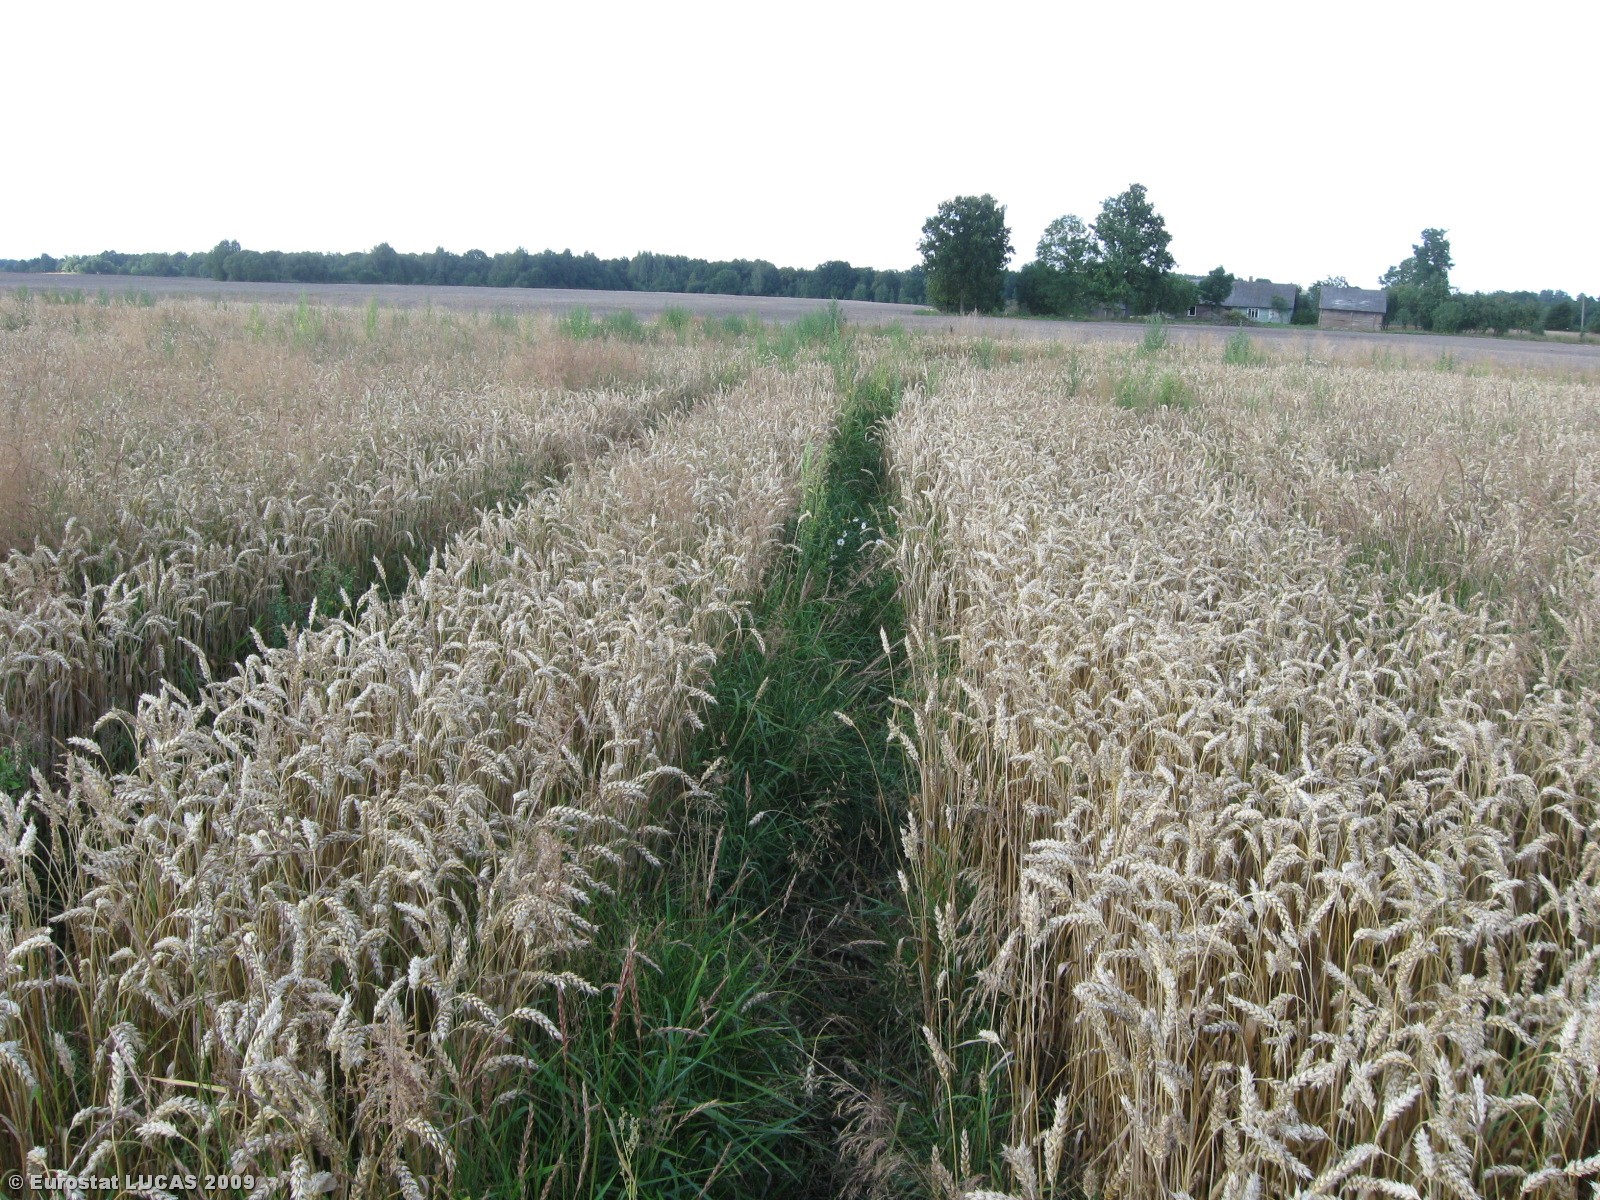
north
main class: Cropland
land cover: Common wheat
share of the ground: > 75 %
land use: Agriculture (excluding fallow land and kitchen gardens)
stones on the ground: < 10 %
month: August
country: LT
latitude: 55.1735
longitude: 22.6728
